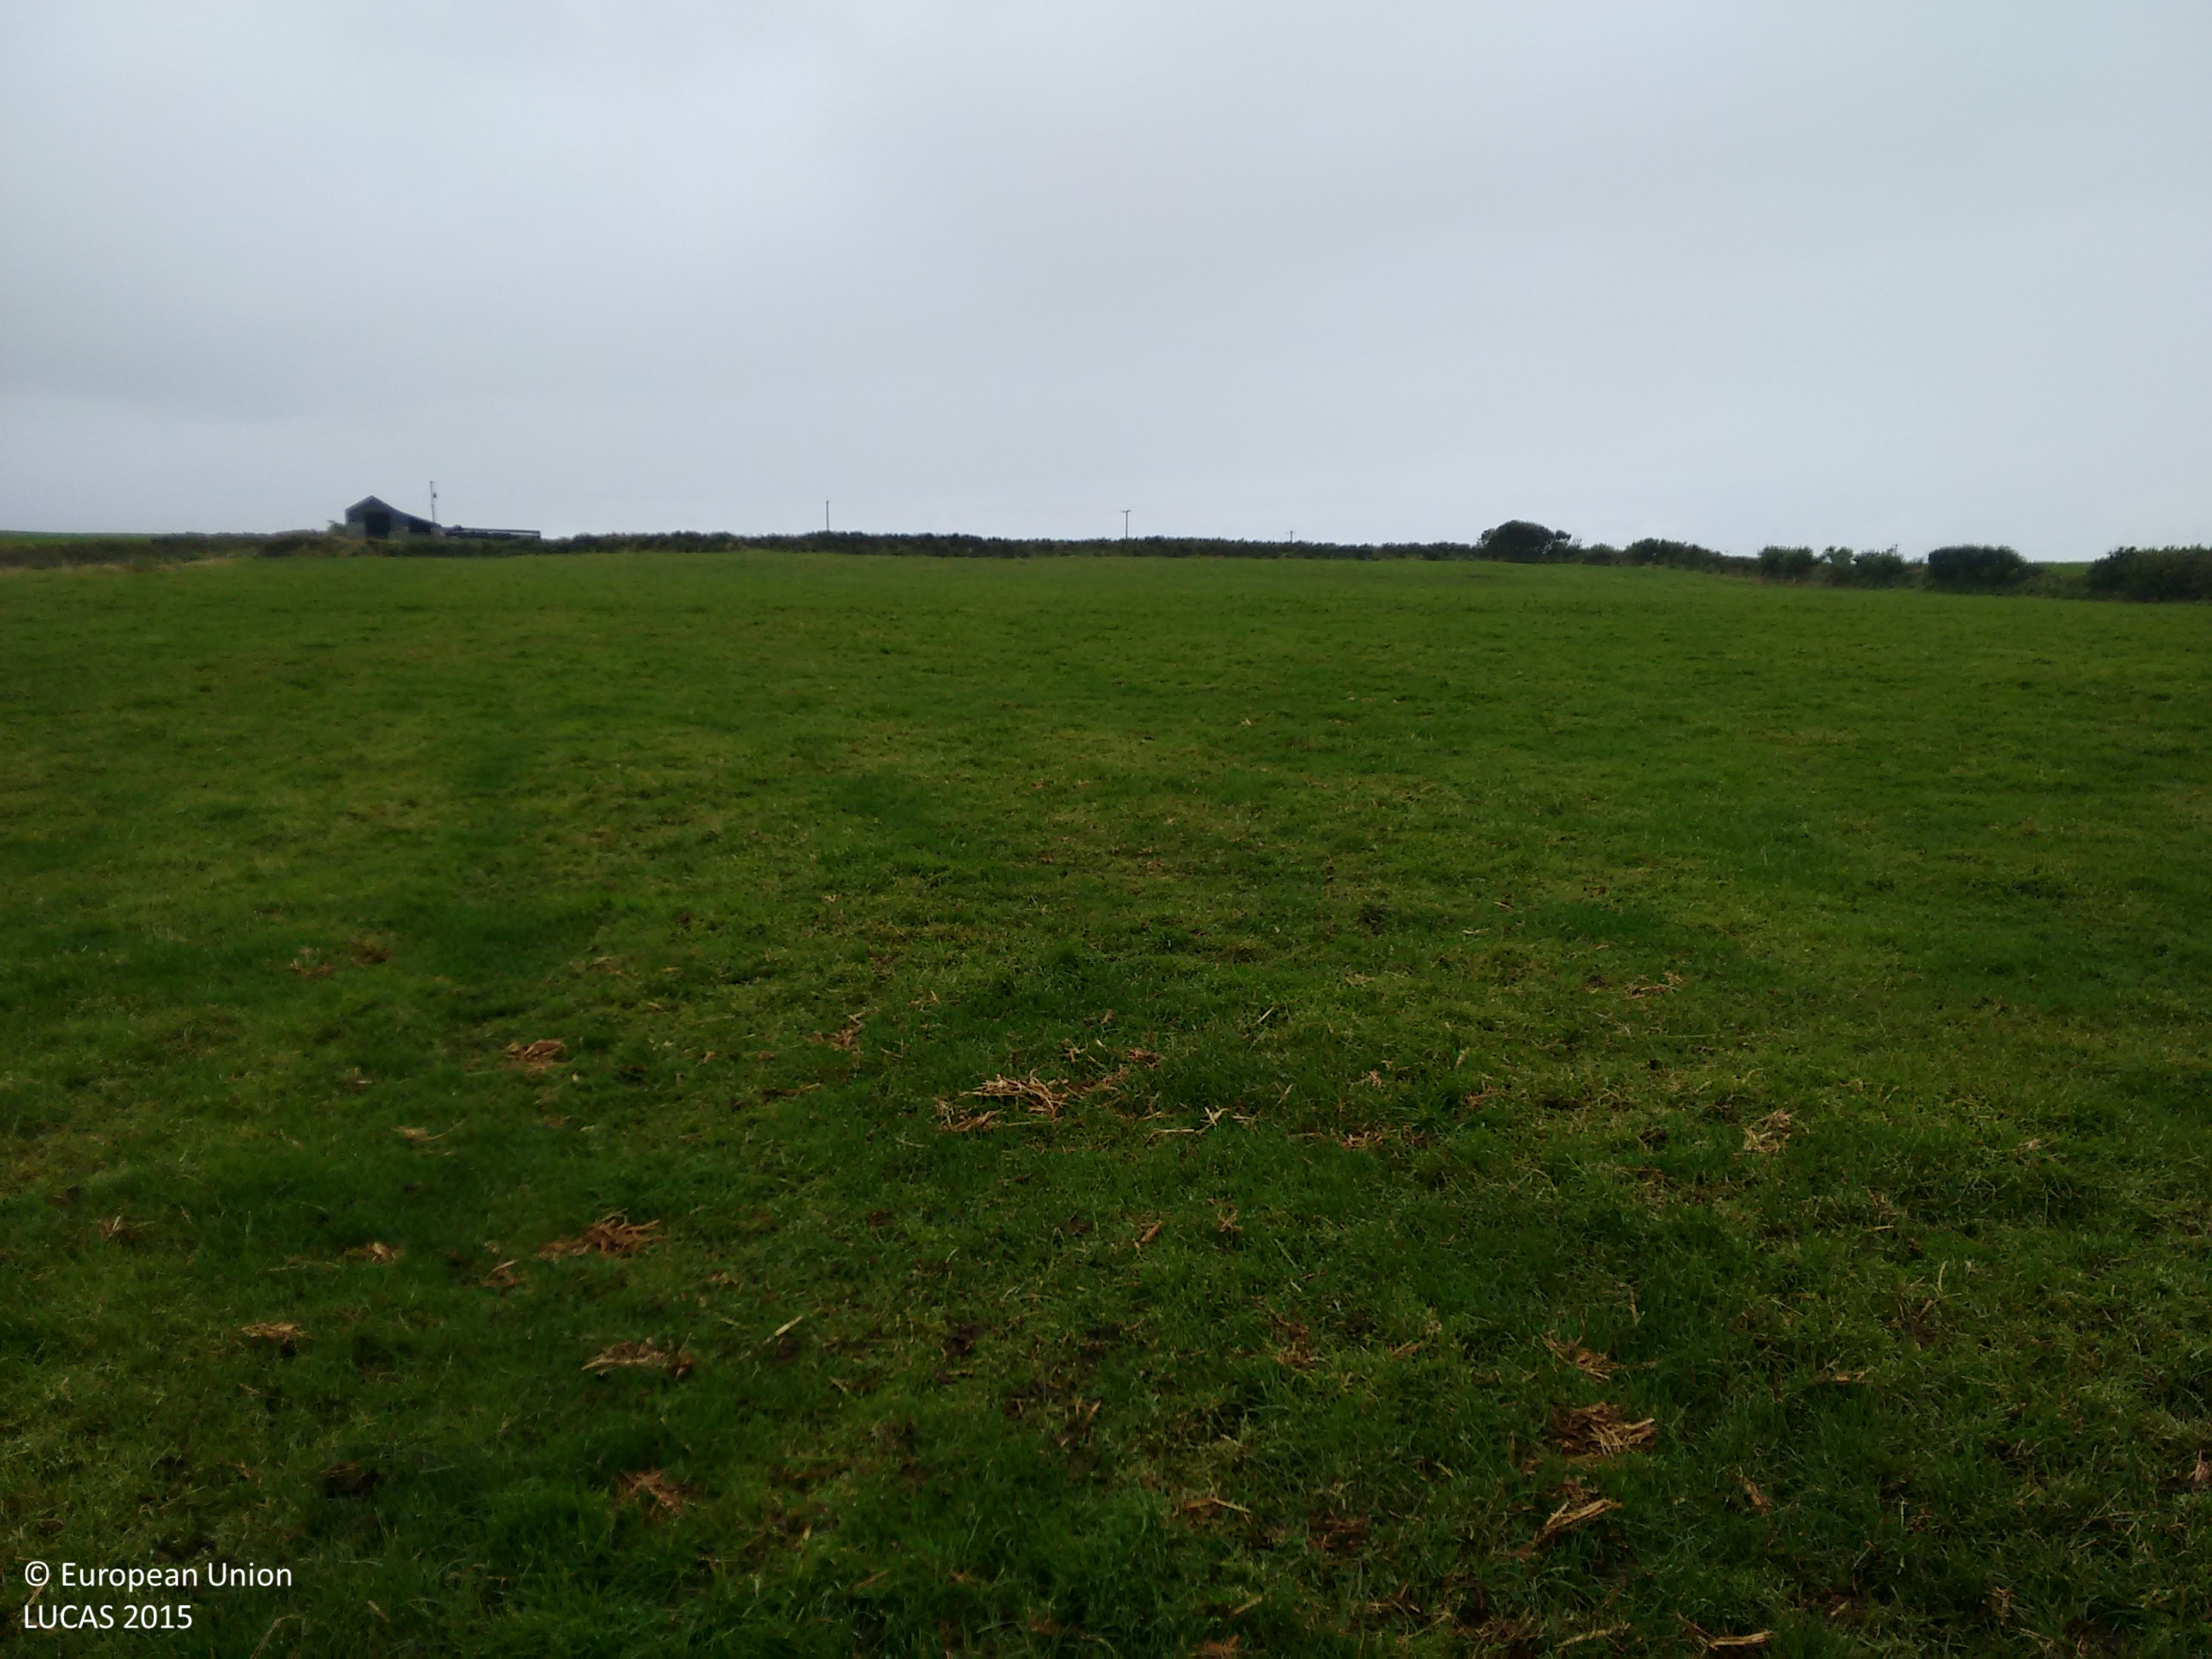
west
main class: Grassland
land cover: Grassland without tree/shrub cover
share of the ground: > 75 %
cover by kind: herbaceous plants 95 %, unconsolidated bare surface 5 %
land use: Agriculture (excluding fallow land and kitchen gardens)
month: September
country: IE
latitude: 52.7014
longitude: -9.6089
